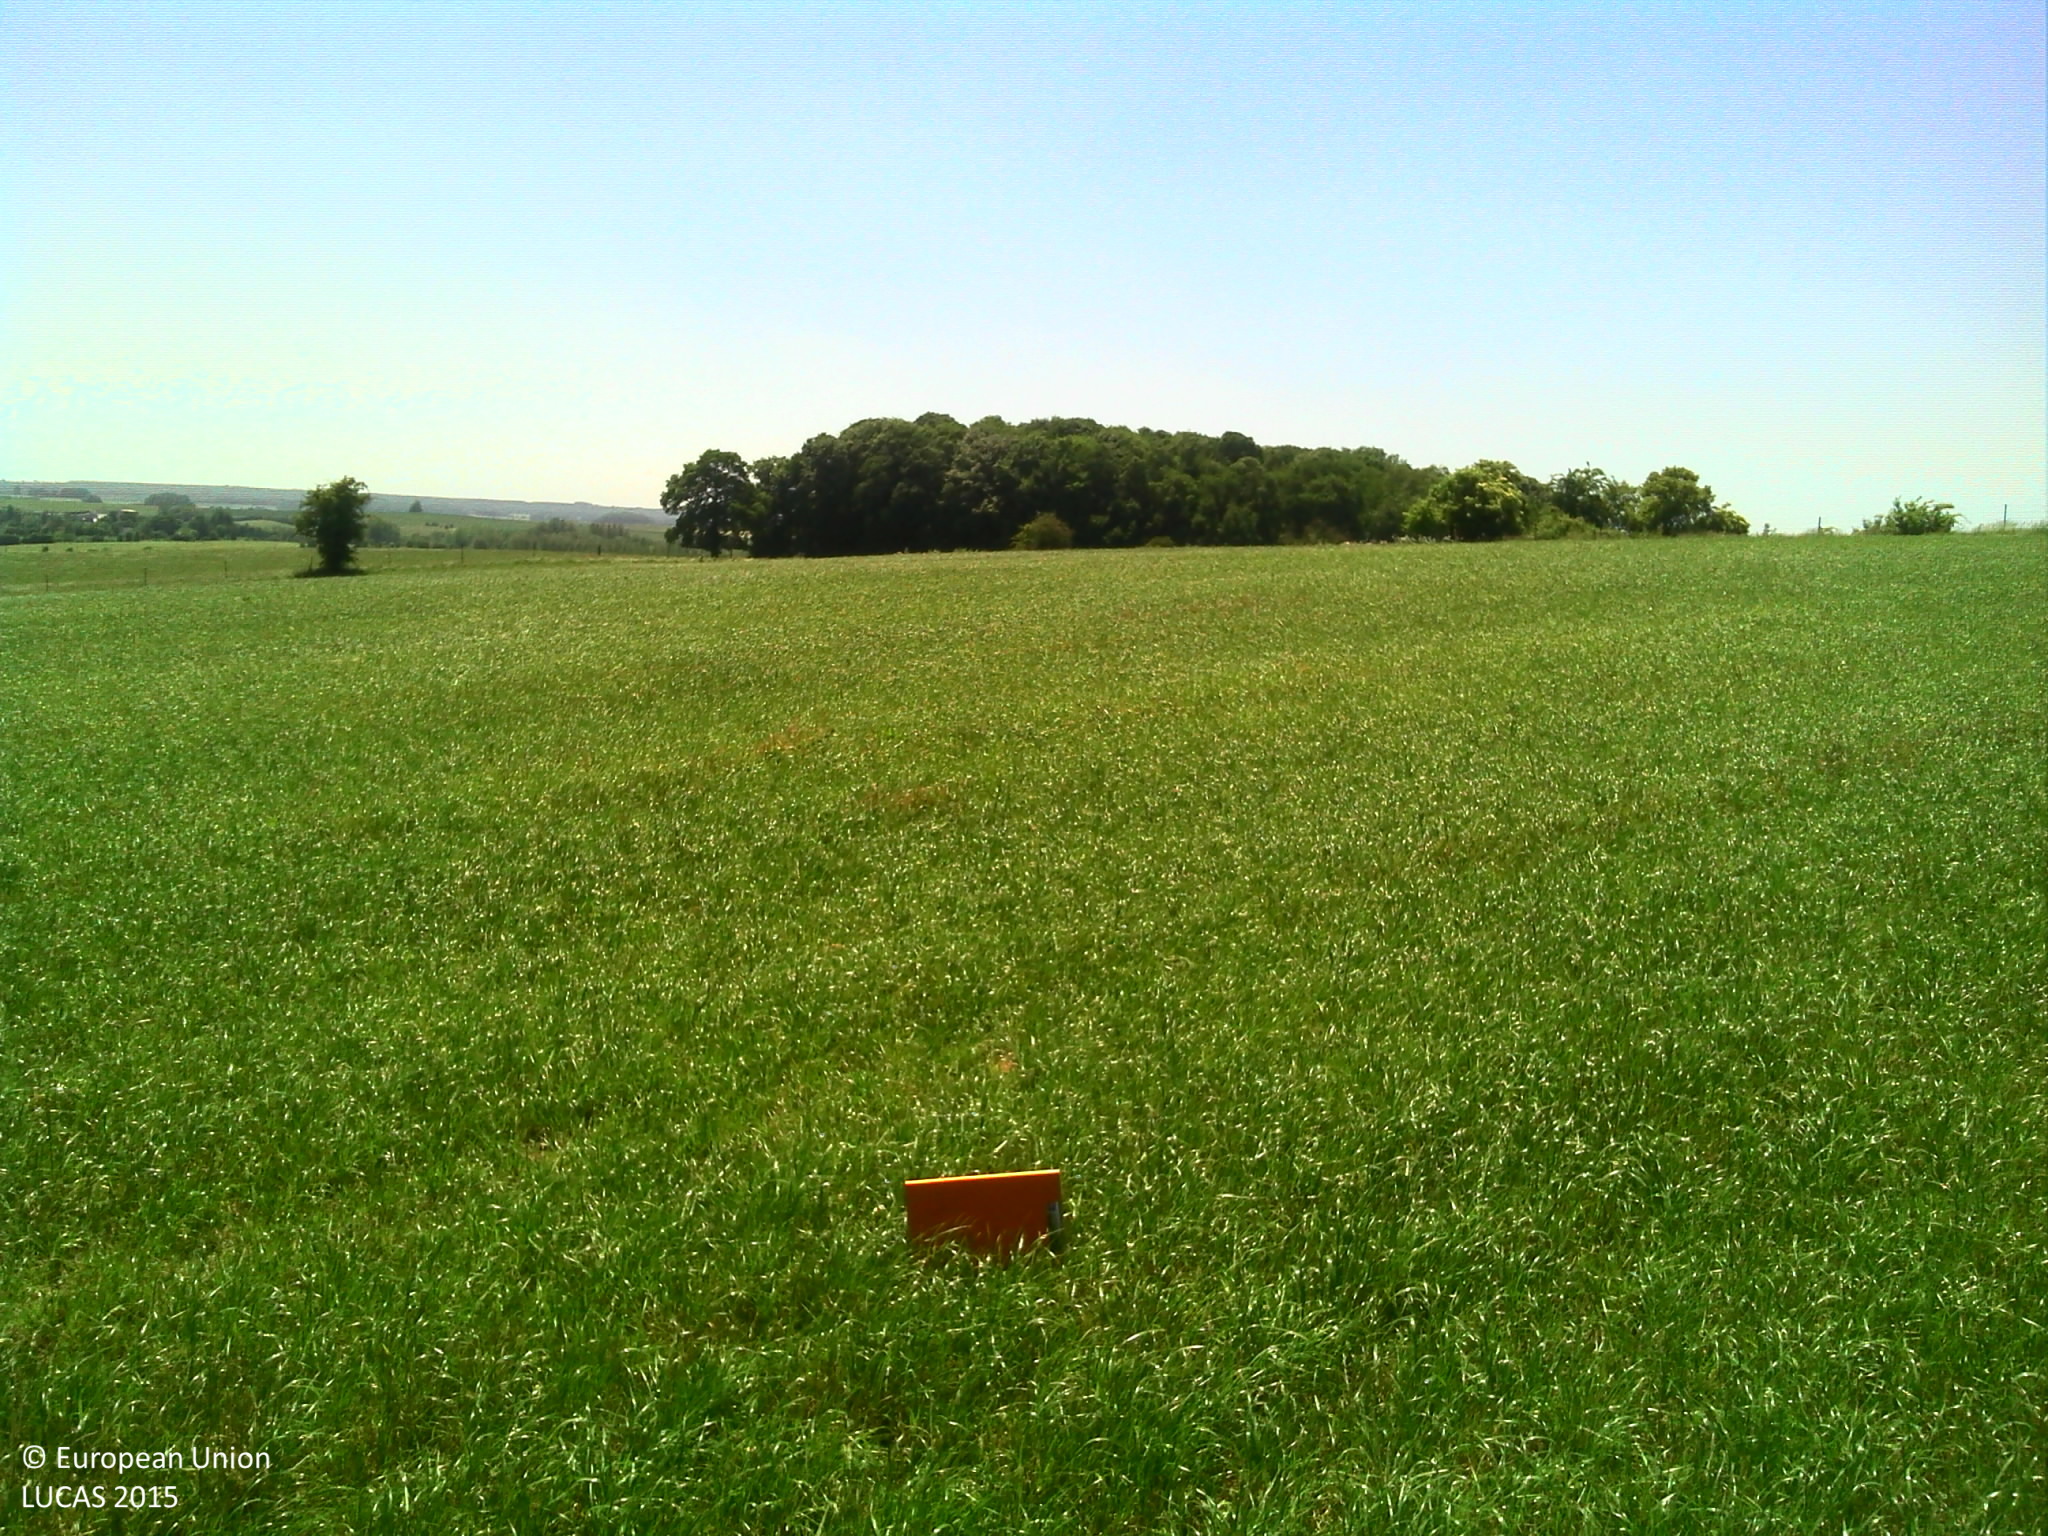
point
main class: Cropland
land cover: Temporary grasslands
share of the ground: > 75 %
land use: Agriculture (excluding fallow land and kitchen gardens)
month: June
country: FR
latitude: 49.8933
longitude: 4.2183
